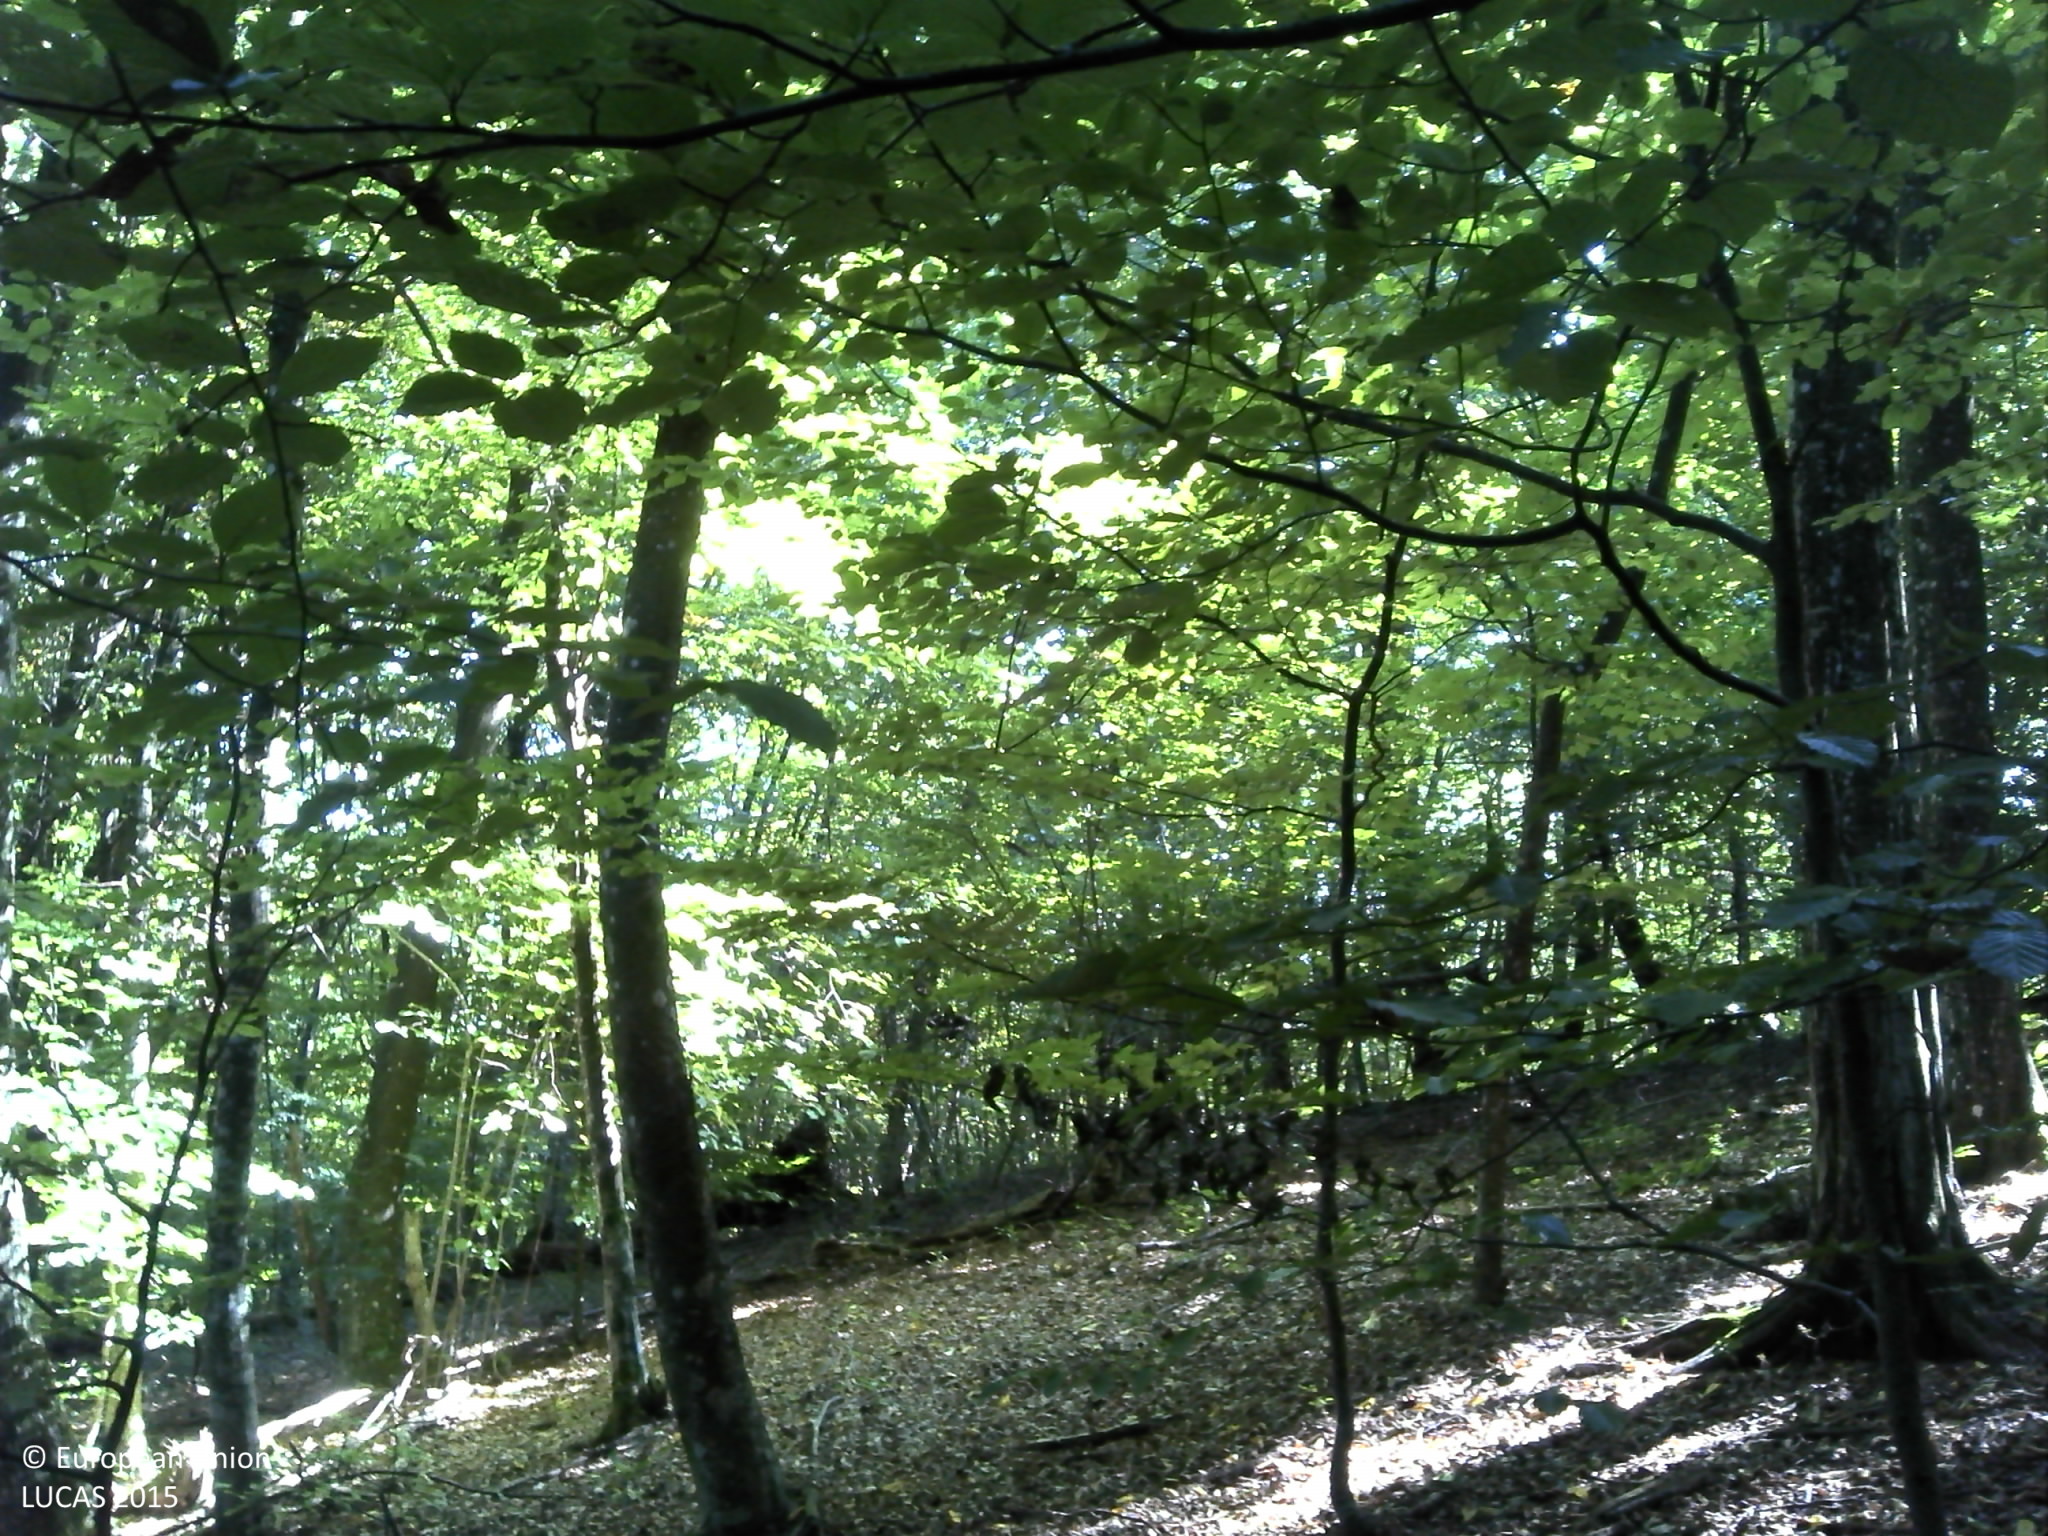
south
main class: Woodland
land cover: Broadleaved woodland
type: beech forest
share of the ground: > 75 %
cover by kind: broadleaved forest trees 100 %
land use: Forestry
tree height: > 5 m
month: August
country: HR
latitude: 45.3144
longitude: 15.6978
